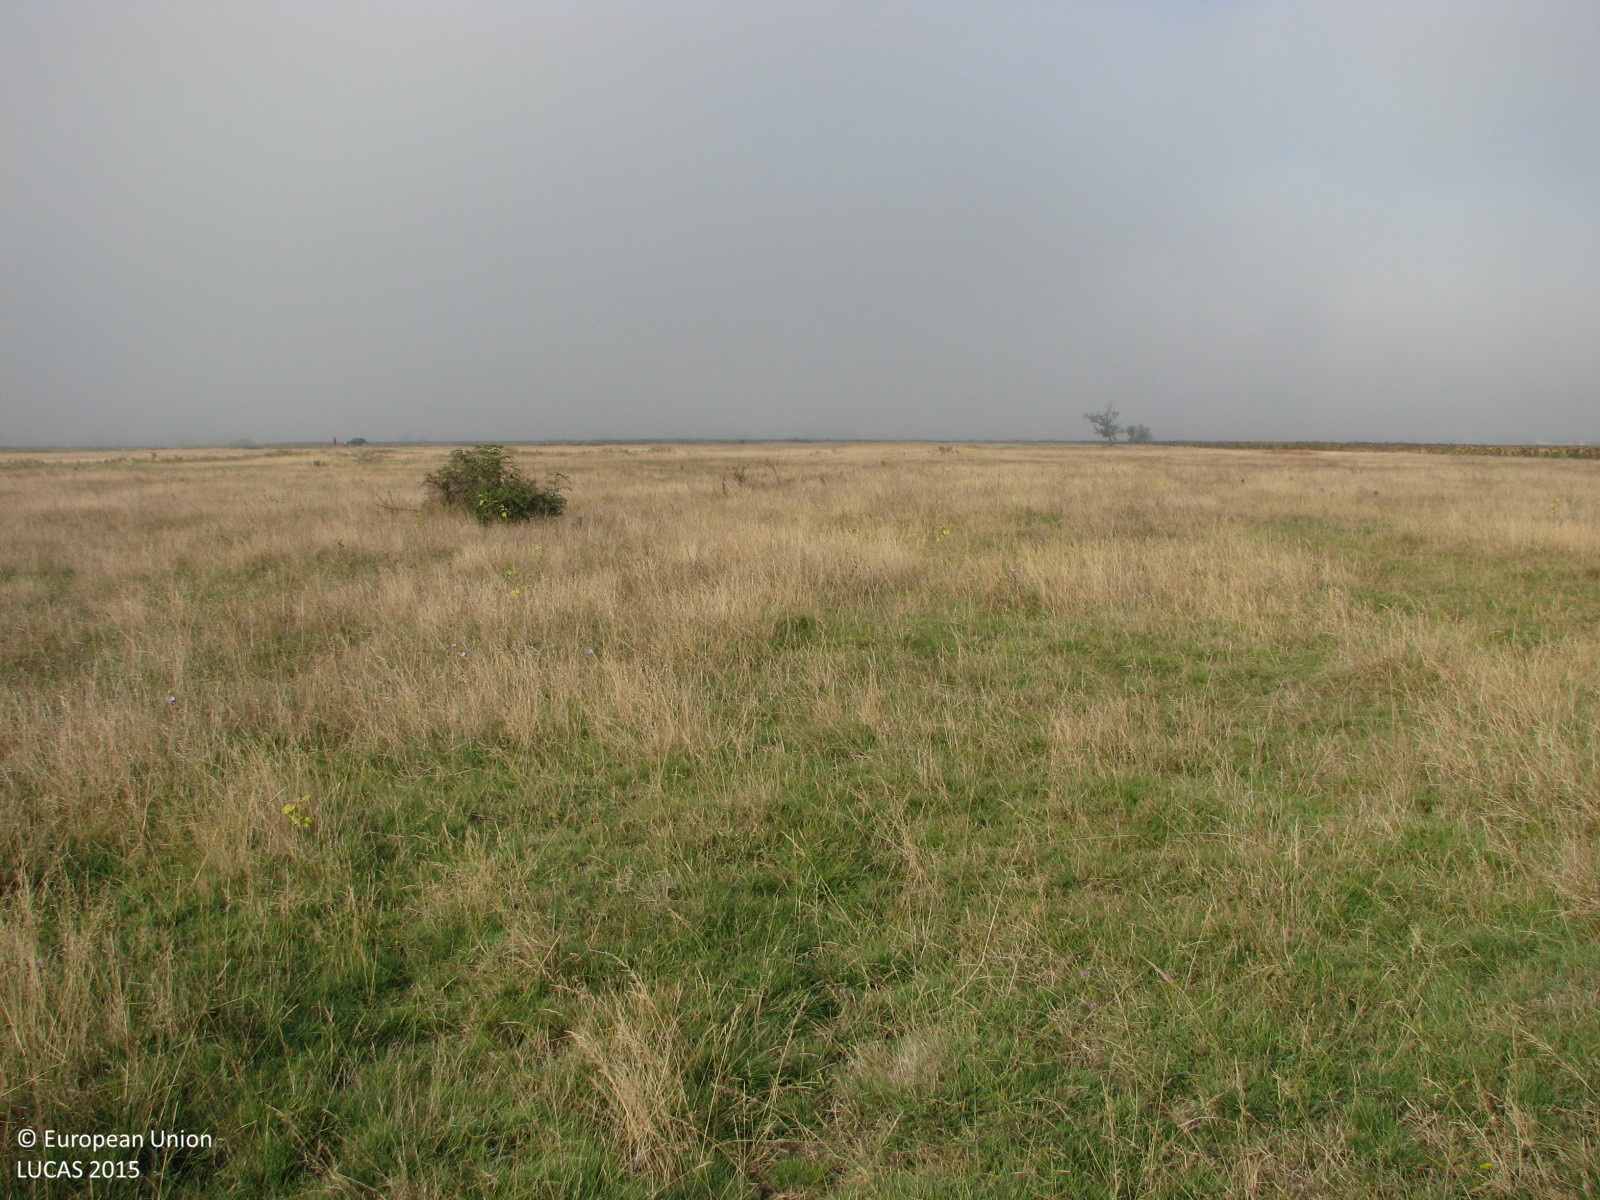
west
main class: Grassland
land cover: Grassland without tree/shrub cover
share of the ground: > 75 %
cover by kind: herbaceous plants 100 %
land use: Agriculture (excluding fallow land and kitchen gardens)
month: October
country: BG
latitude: 42.4192
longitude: 25.8883
